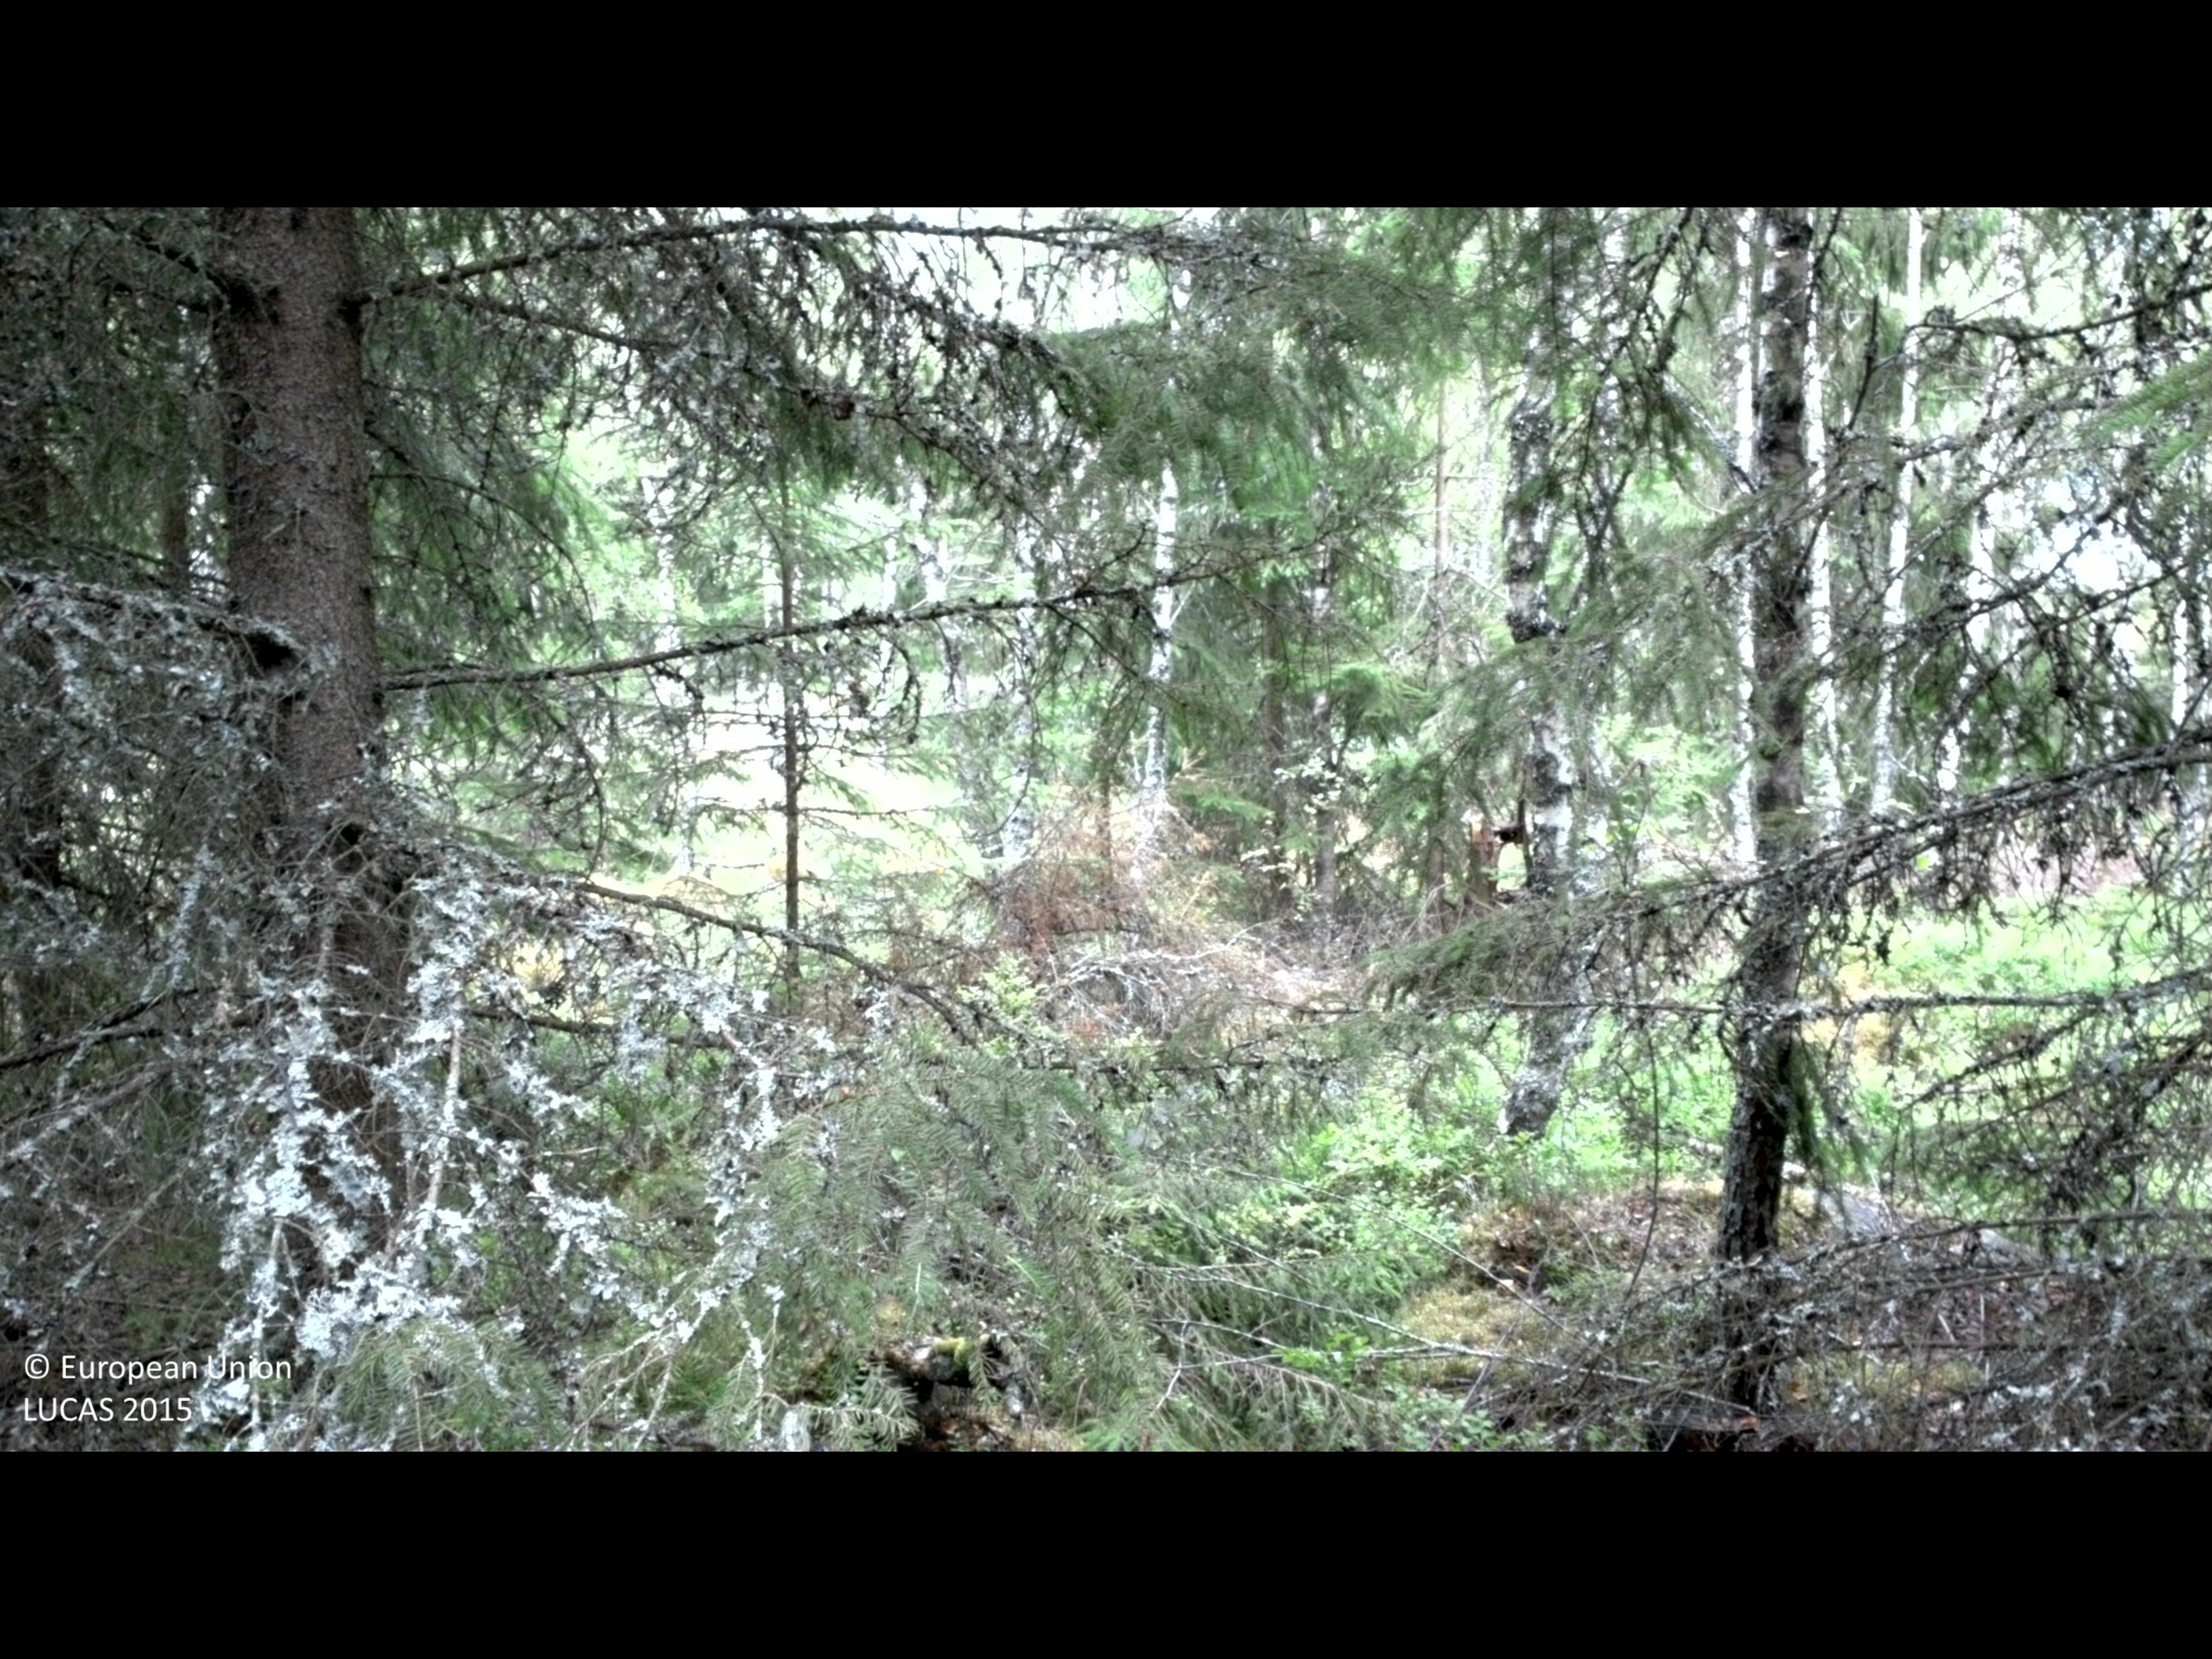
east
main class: Woodland
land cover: Spruce dominated mixed woodland
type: boreal forest
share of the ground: 50 - 75 %
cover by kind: coniferous forest trees 50 %, shrubs 25 %, broadleaved forest trees 20 %, lichens and mosses 5 %
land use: Forestry
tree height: > 5 m
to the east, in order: Spruce dominated mixed woodland; Shruby margins; Paved roads, cycling and walking lanes; Shruby margins; Other coniferous woodland; Spruce dominated coniferous woodland; Other mixed woodland
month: July
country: SE
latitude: 56.5063
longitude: 14.4657
